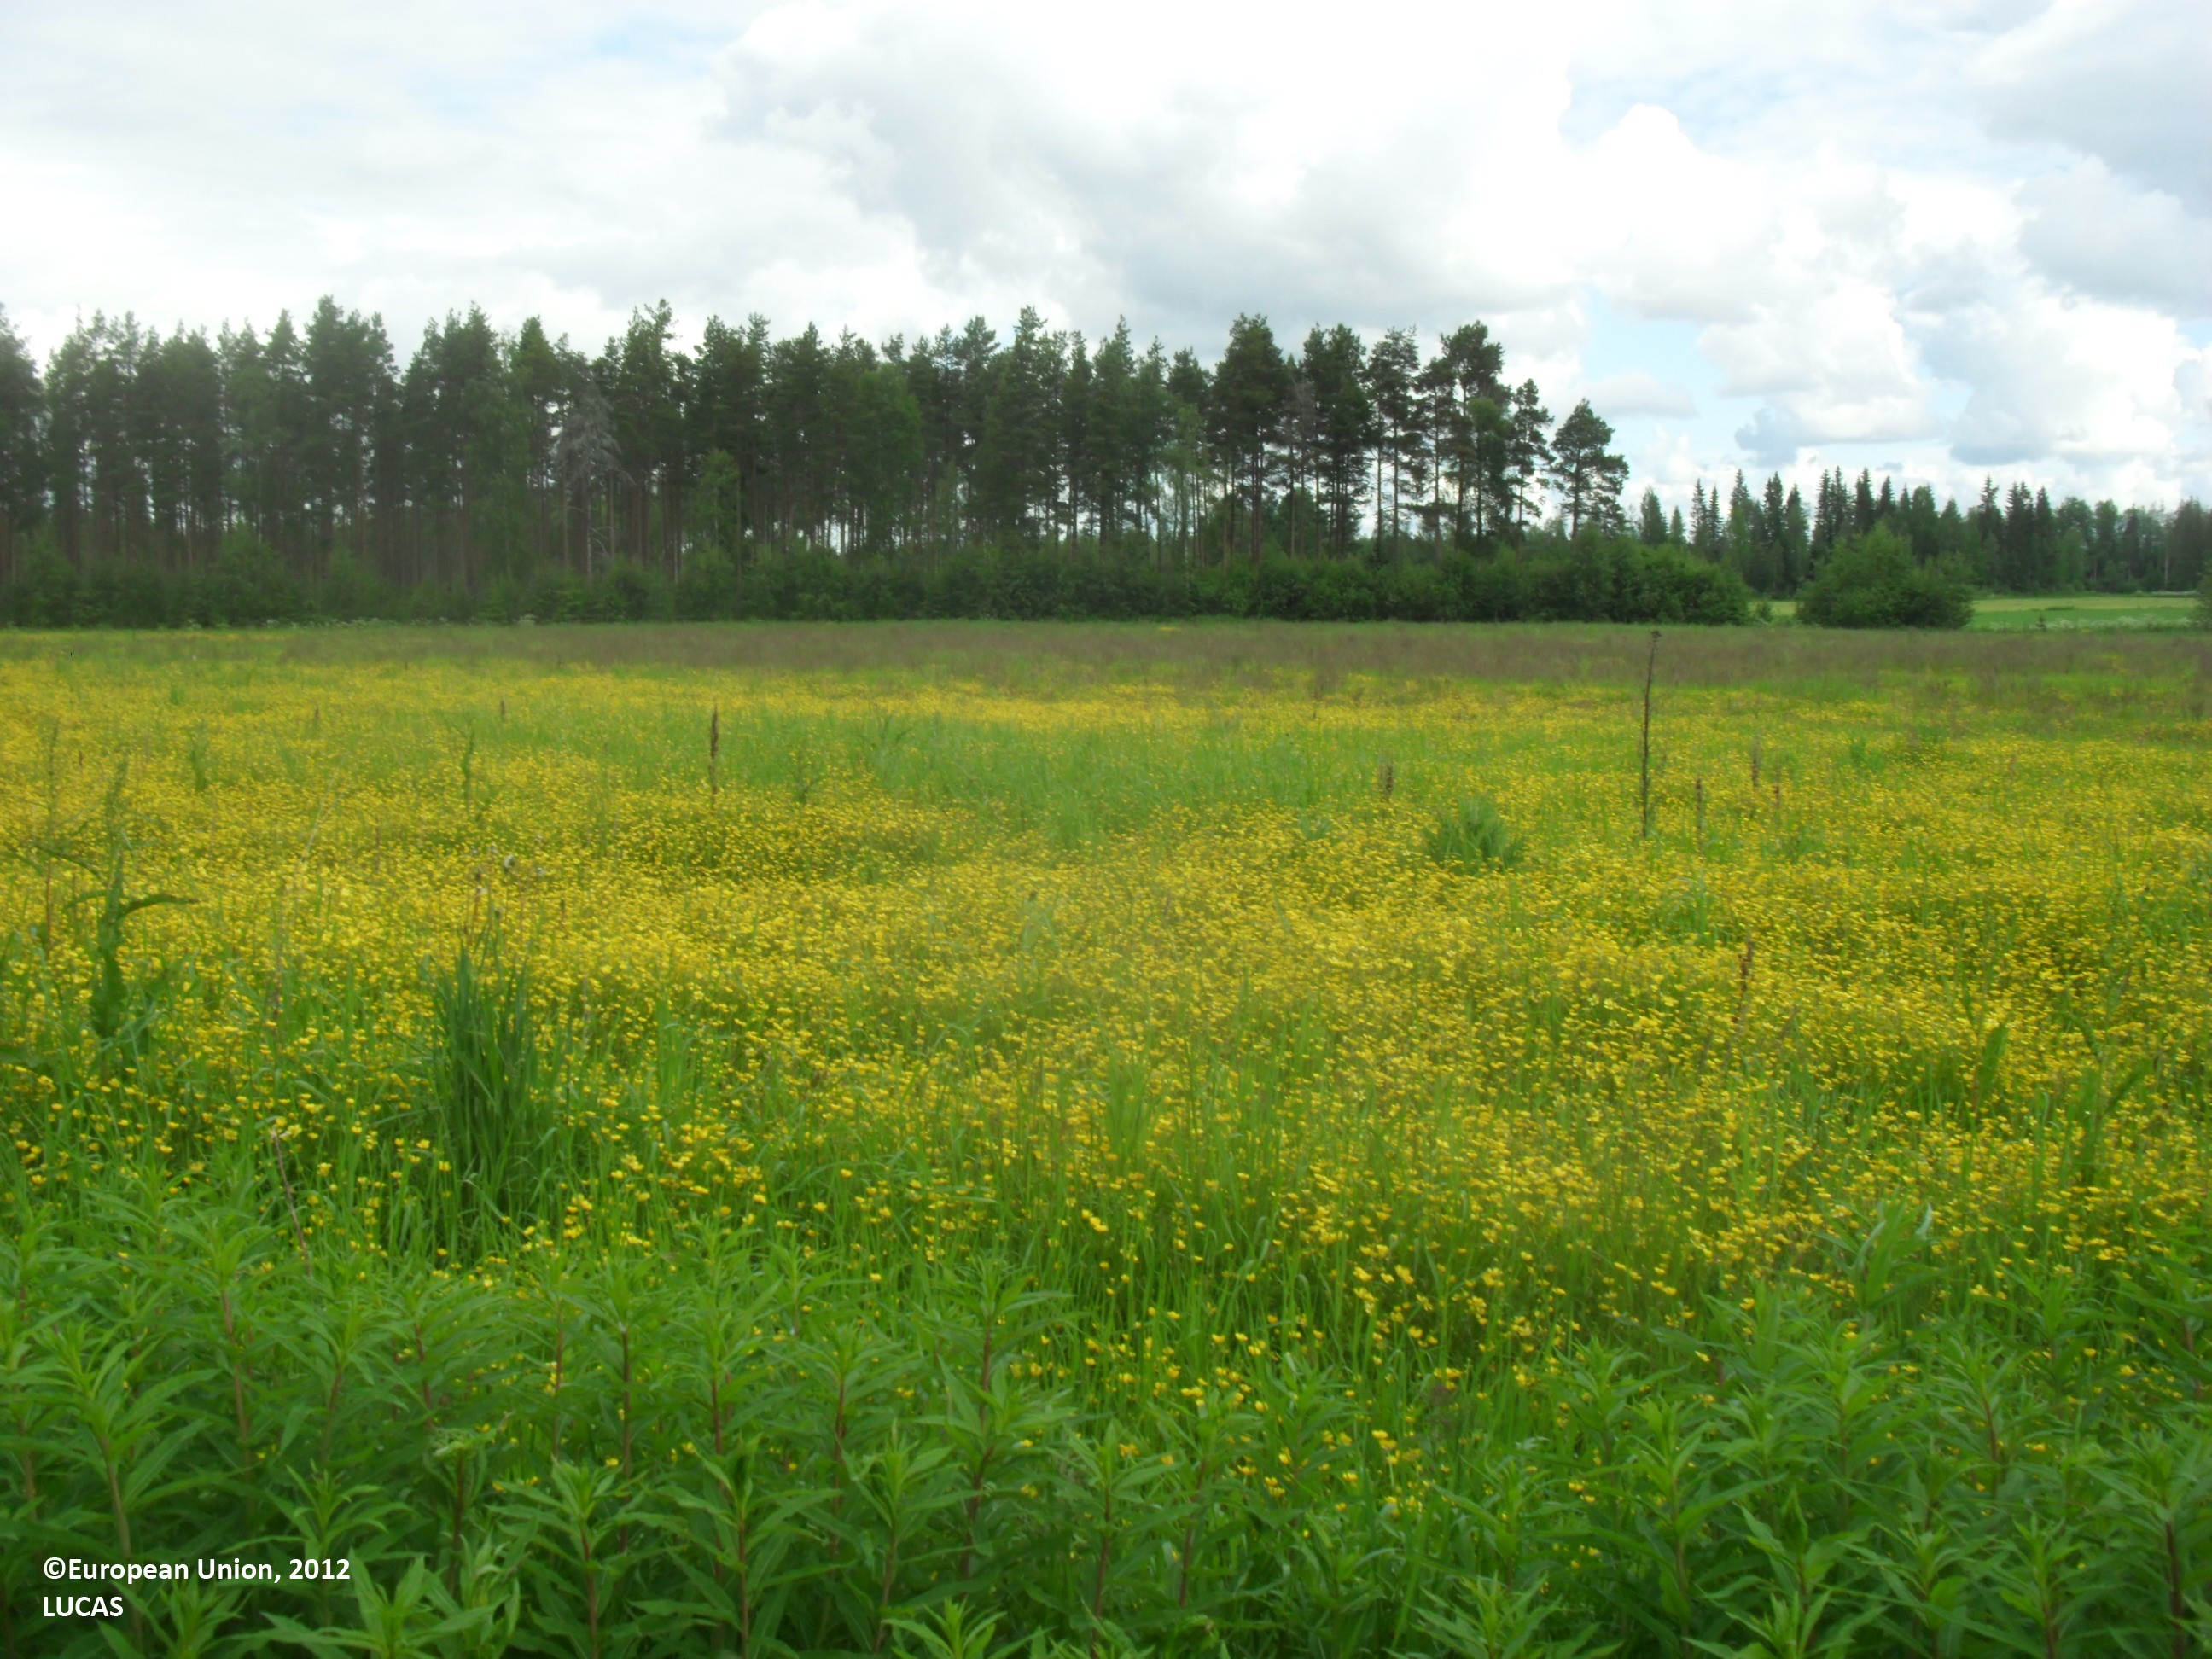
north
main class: Cropland
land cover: Barley
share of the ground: 25 - 50 %
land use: Agriculture (excluding fallow land and kitchen gardens)
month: June
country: FI
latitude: 63.3535
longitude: 23.3514
